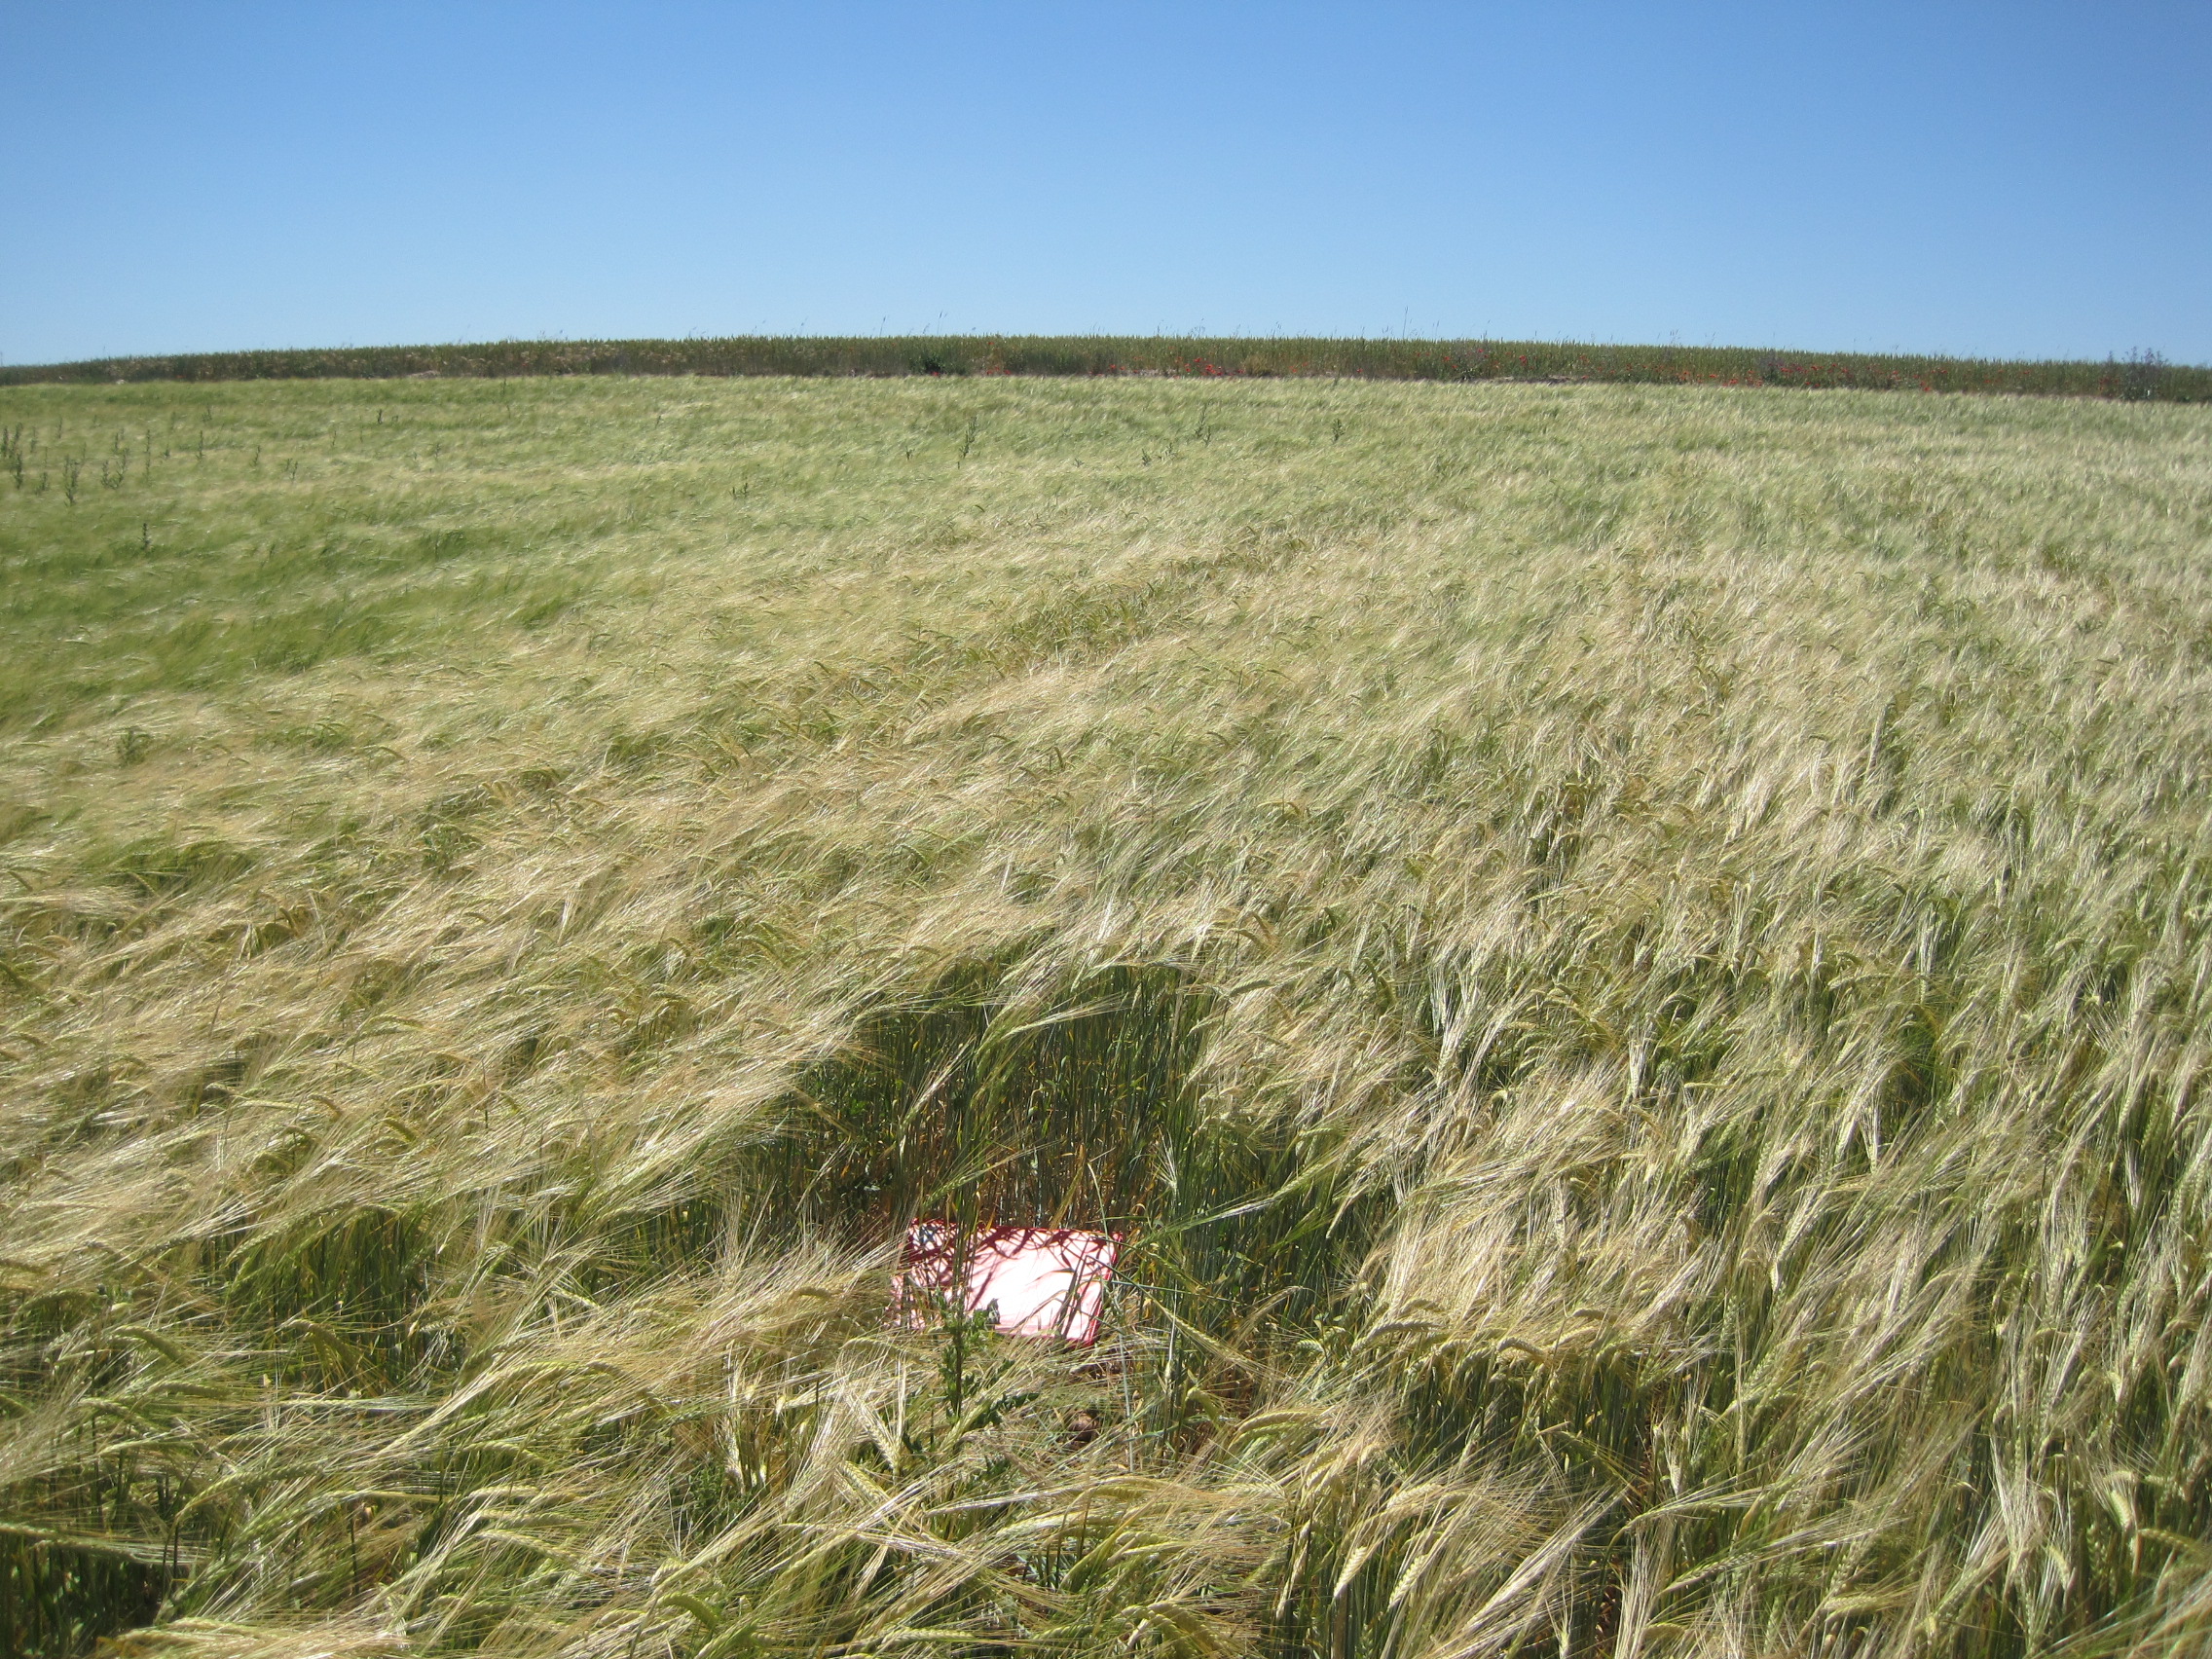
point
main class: Cropland
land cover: Barley
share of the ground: > 75 %
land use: Agriculture (excluding fallow land and kitchen gardens)
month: May
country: ES
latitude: 41.2822
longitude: -5.2976
